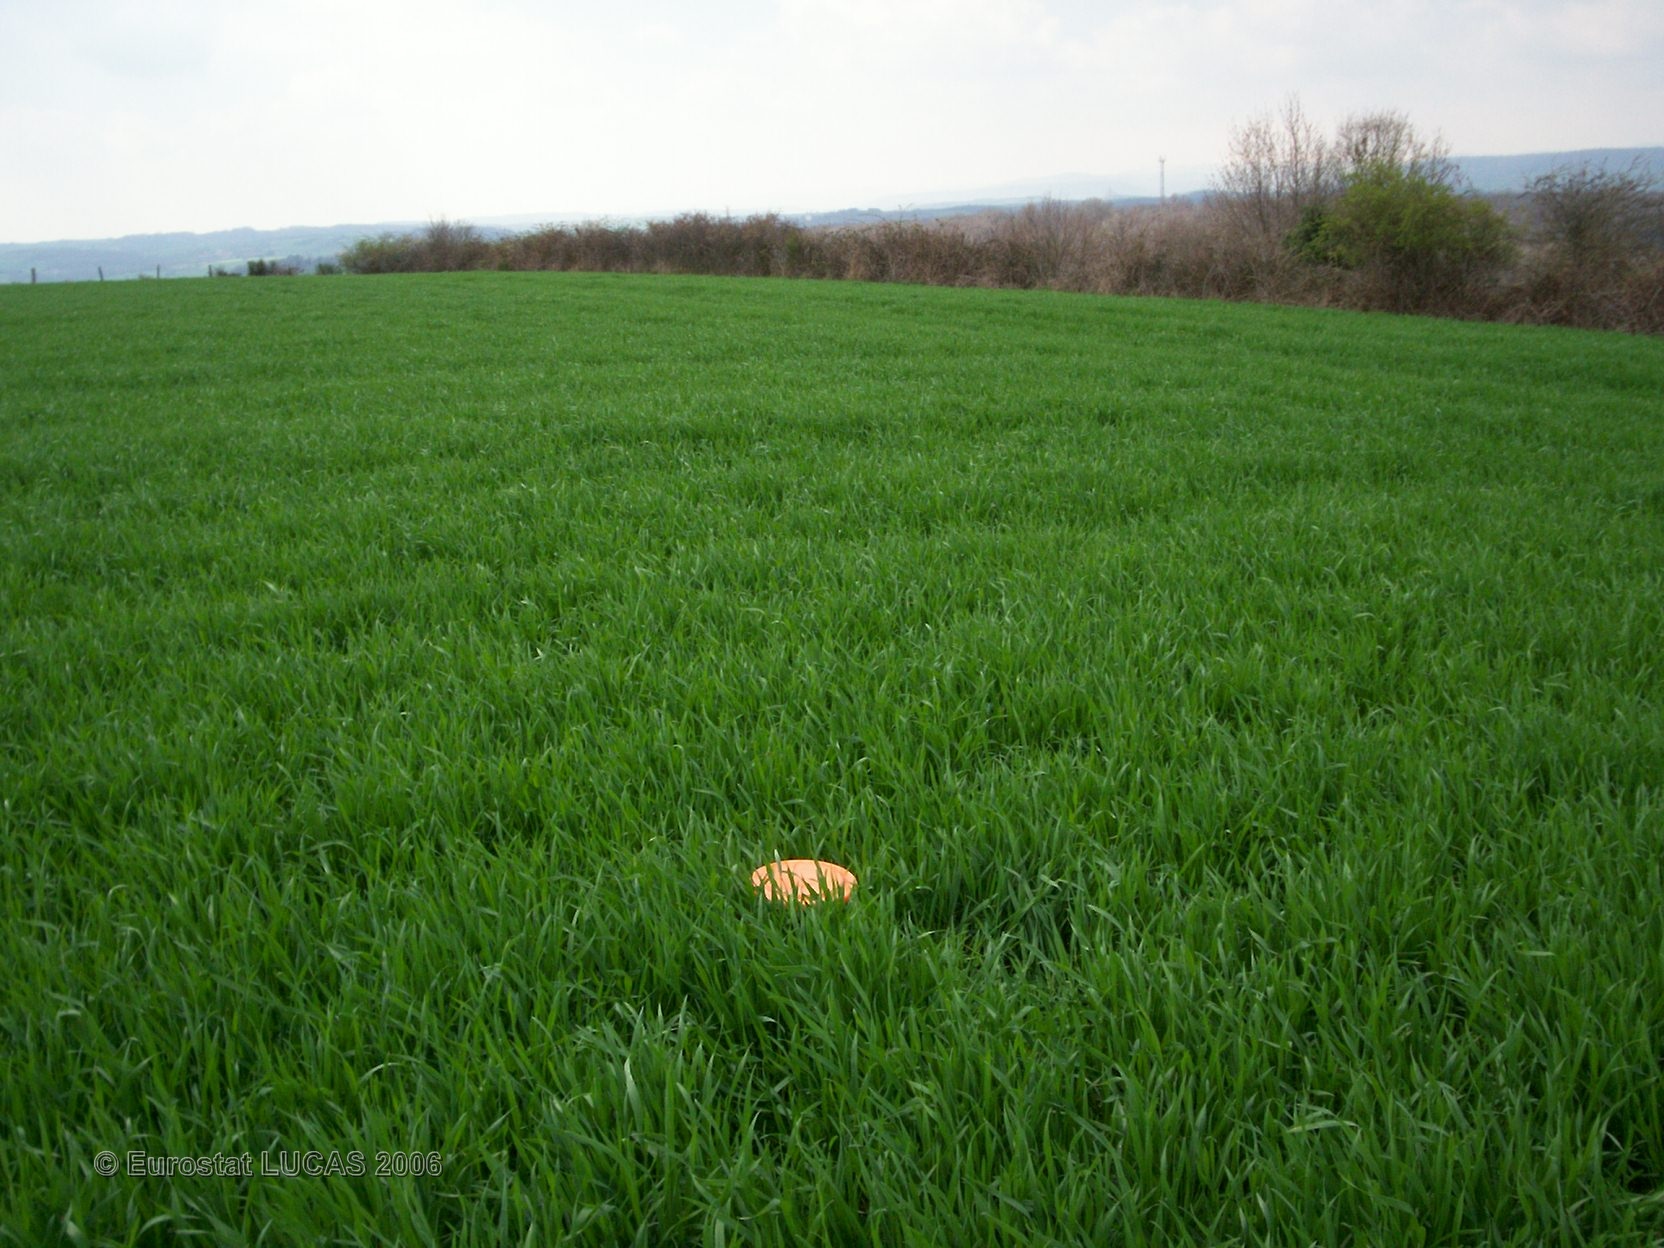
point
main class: Cropland
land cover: Common wheat
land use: Agriculture (excluding fallow land and kitchen gardens)
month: April
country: FR
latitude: 45.3833
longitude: 3.3223
